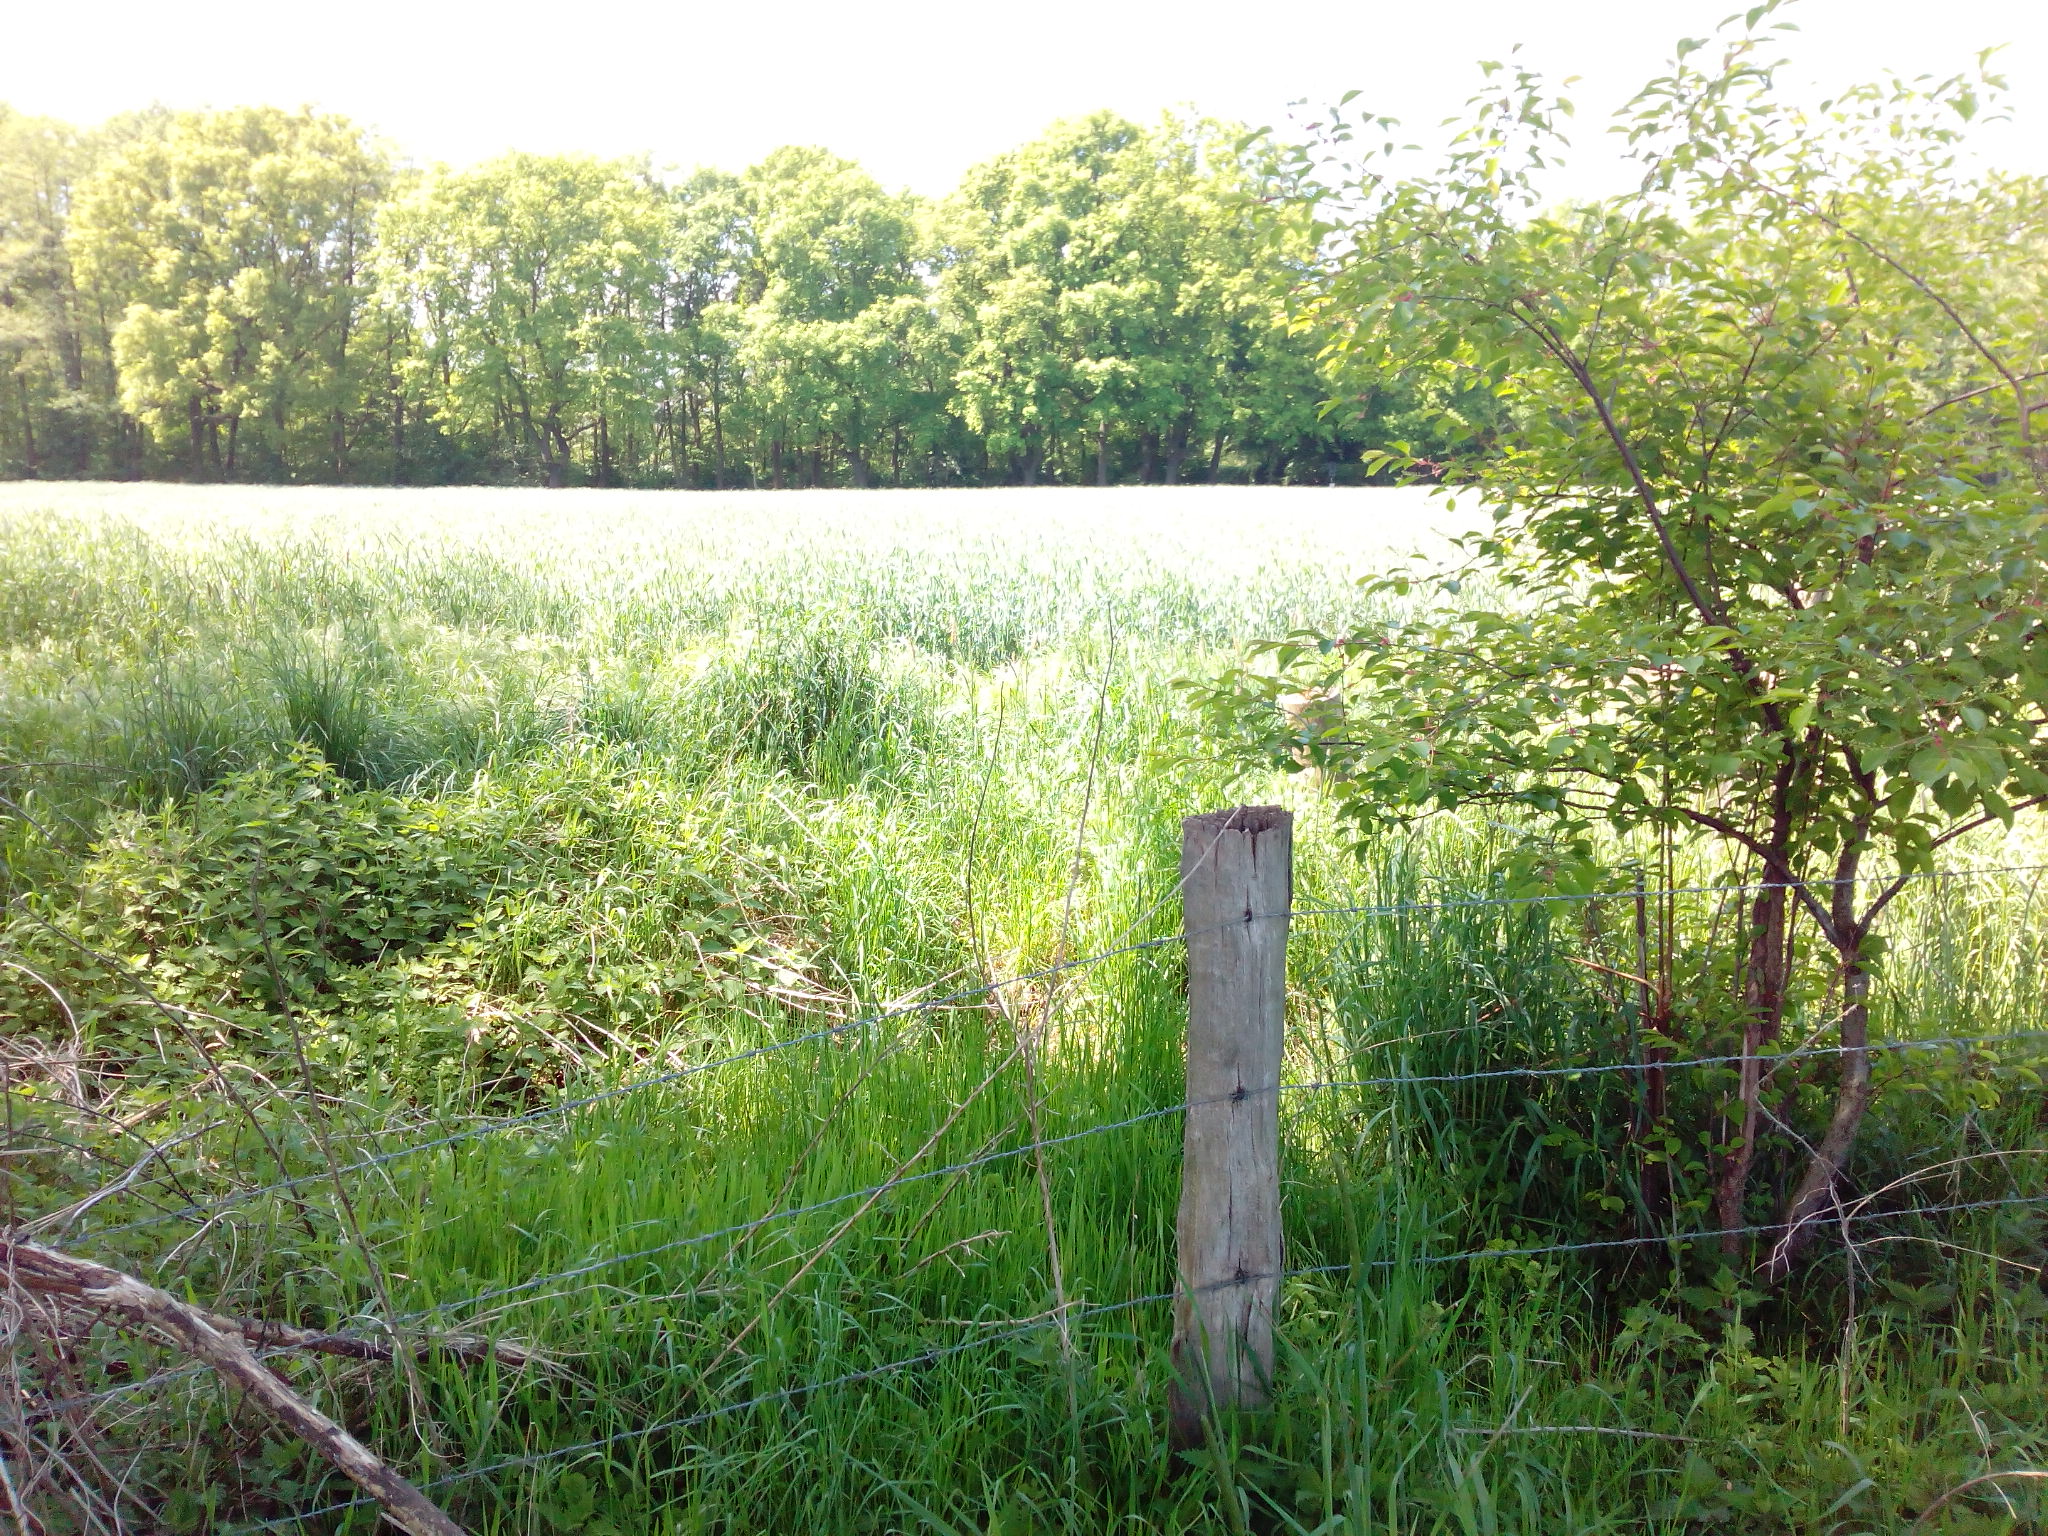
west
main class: Woodland
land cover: Broadleaved woodland
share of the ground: > 75 %
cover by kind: broadleaved forest trees 100 %
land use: Agriculture (excluding fallow land and kitchen gardens)
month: May
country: DE
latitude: 52.4308
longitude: 9.6324
